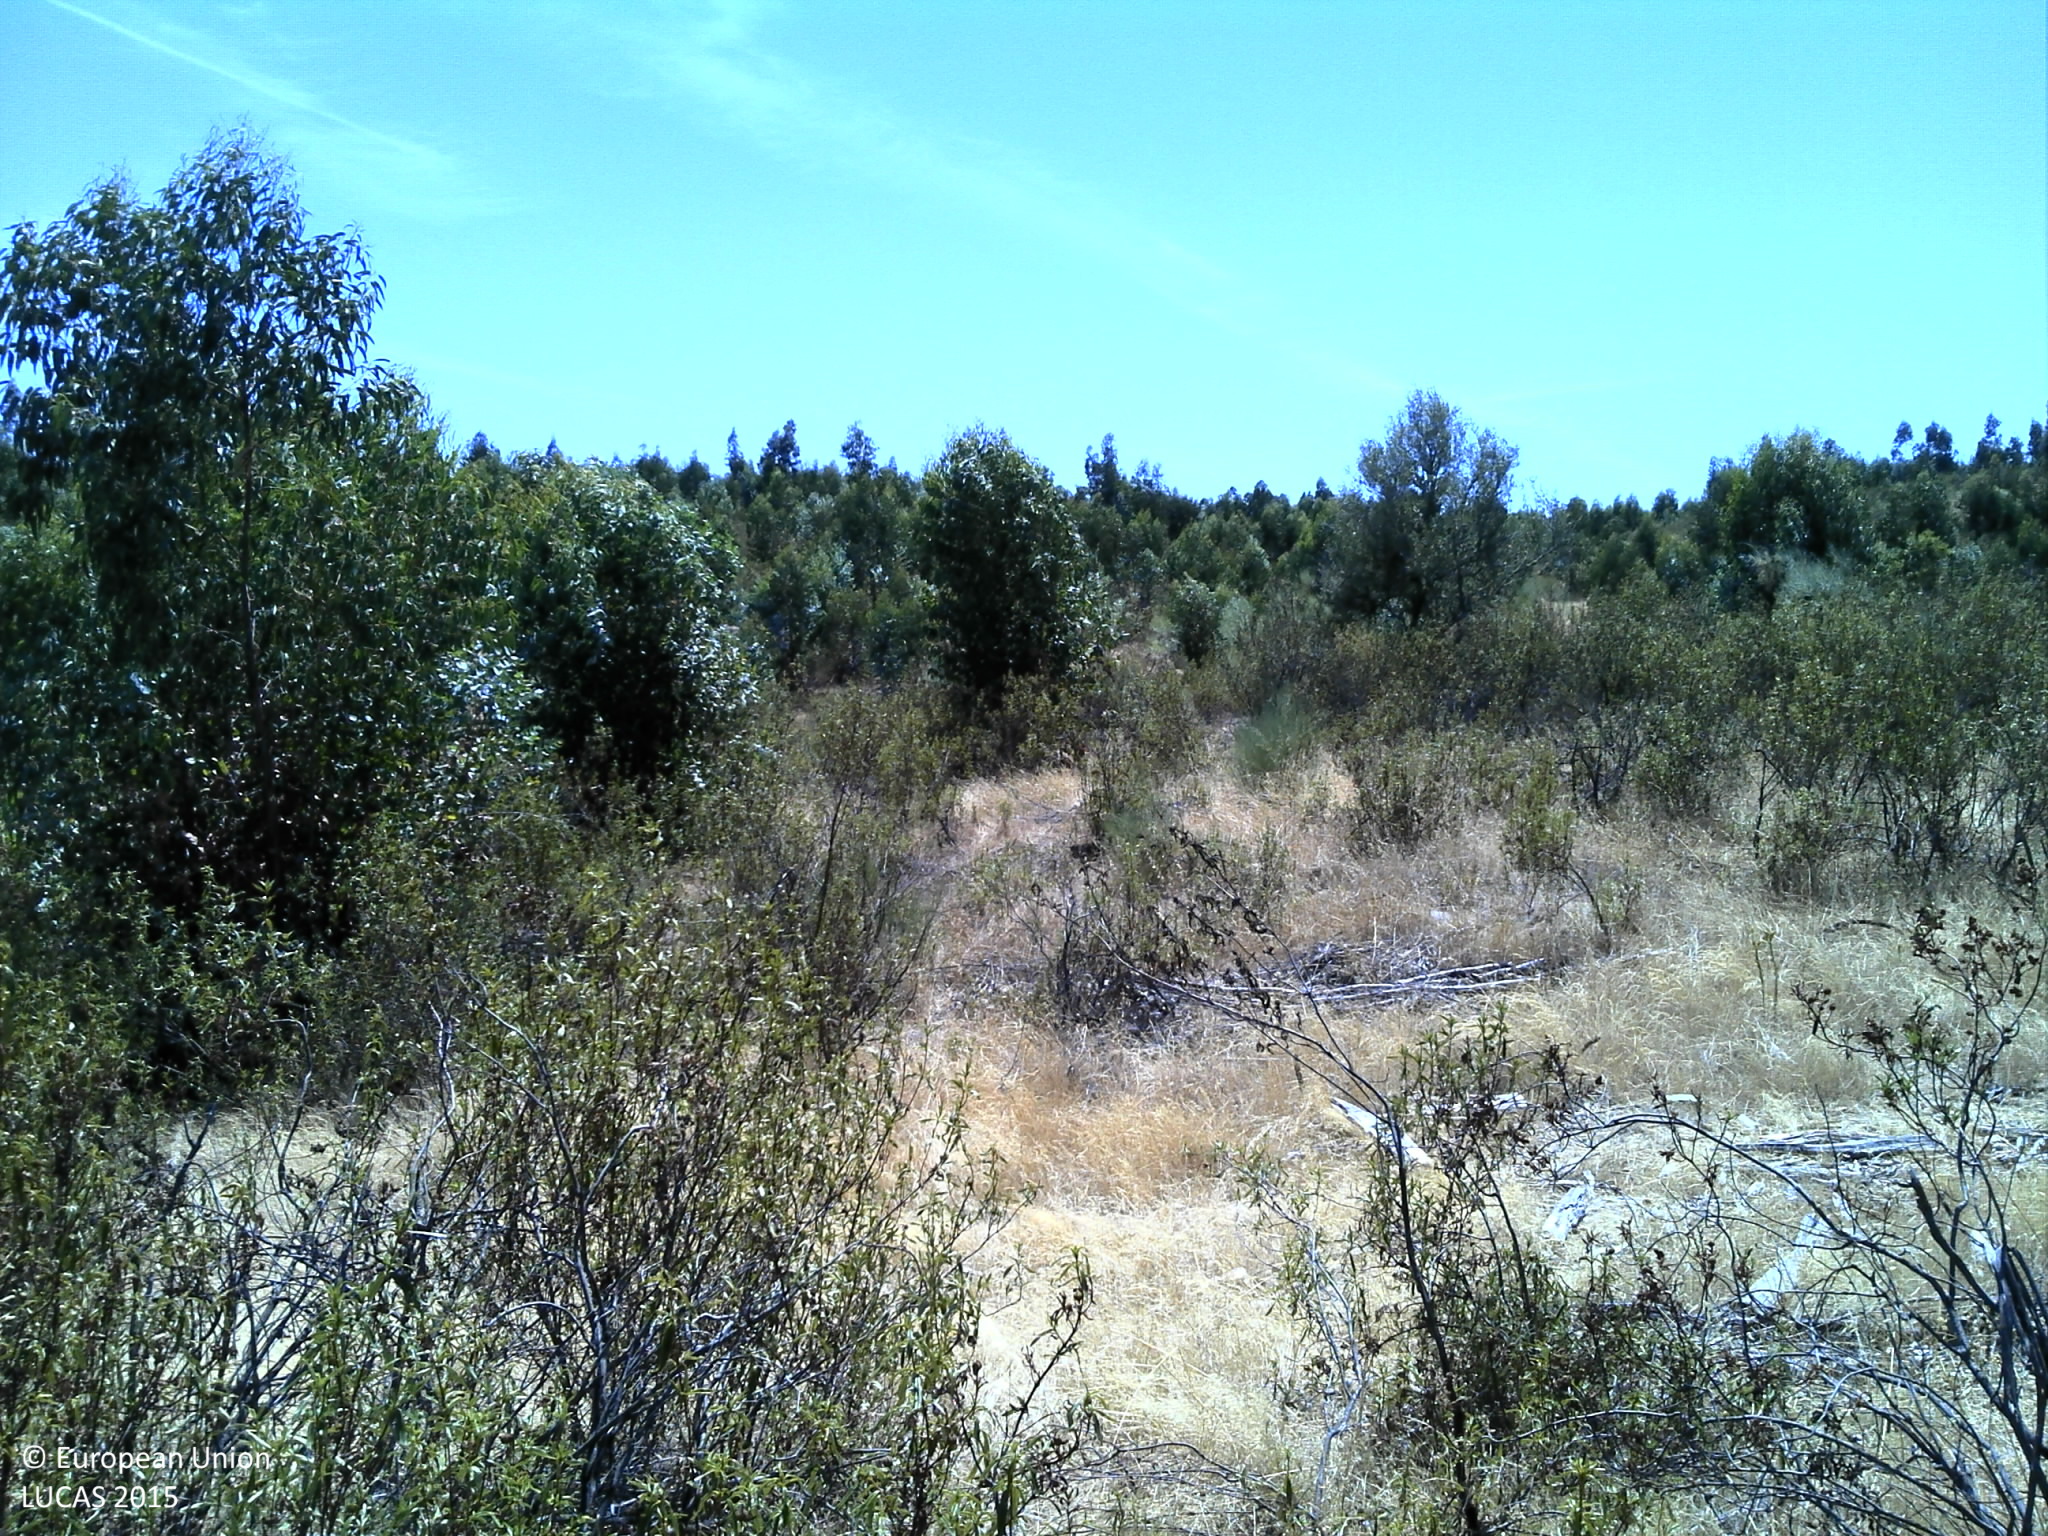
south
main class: Woodland
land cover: Broadleaved woodland
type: exotic forest
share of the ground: 10 - 25 %
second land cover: Shrubland without tree cover
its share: > 75 %
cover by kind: shrubs 90 %, broadleaved forest trees 10 %
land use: Forestry
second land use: Agriculture (excluding fallow land and kitchen gardens)
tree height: > 5 m
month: August
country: PT
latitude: 39.5364
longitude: -7.4642
